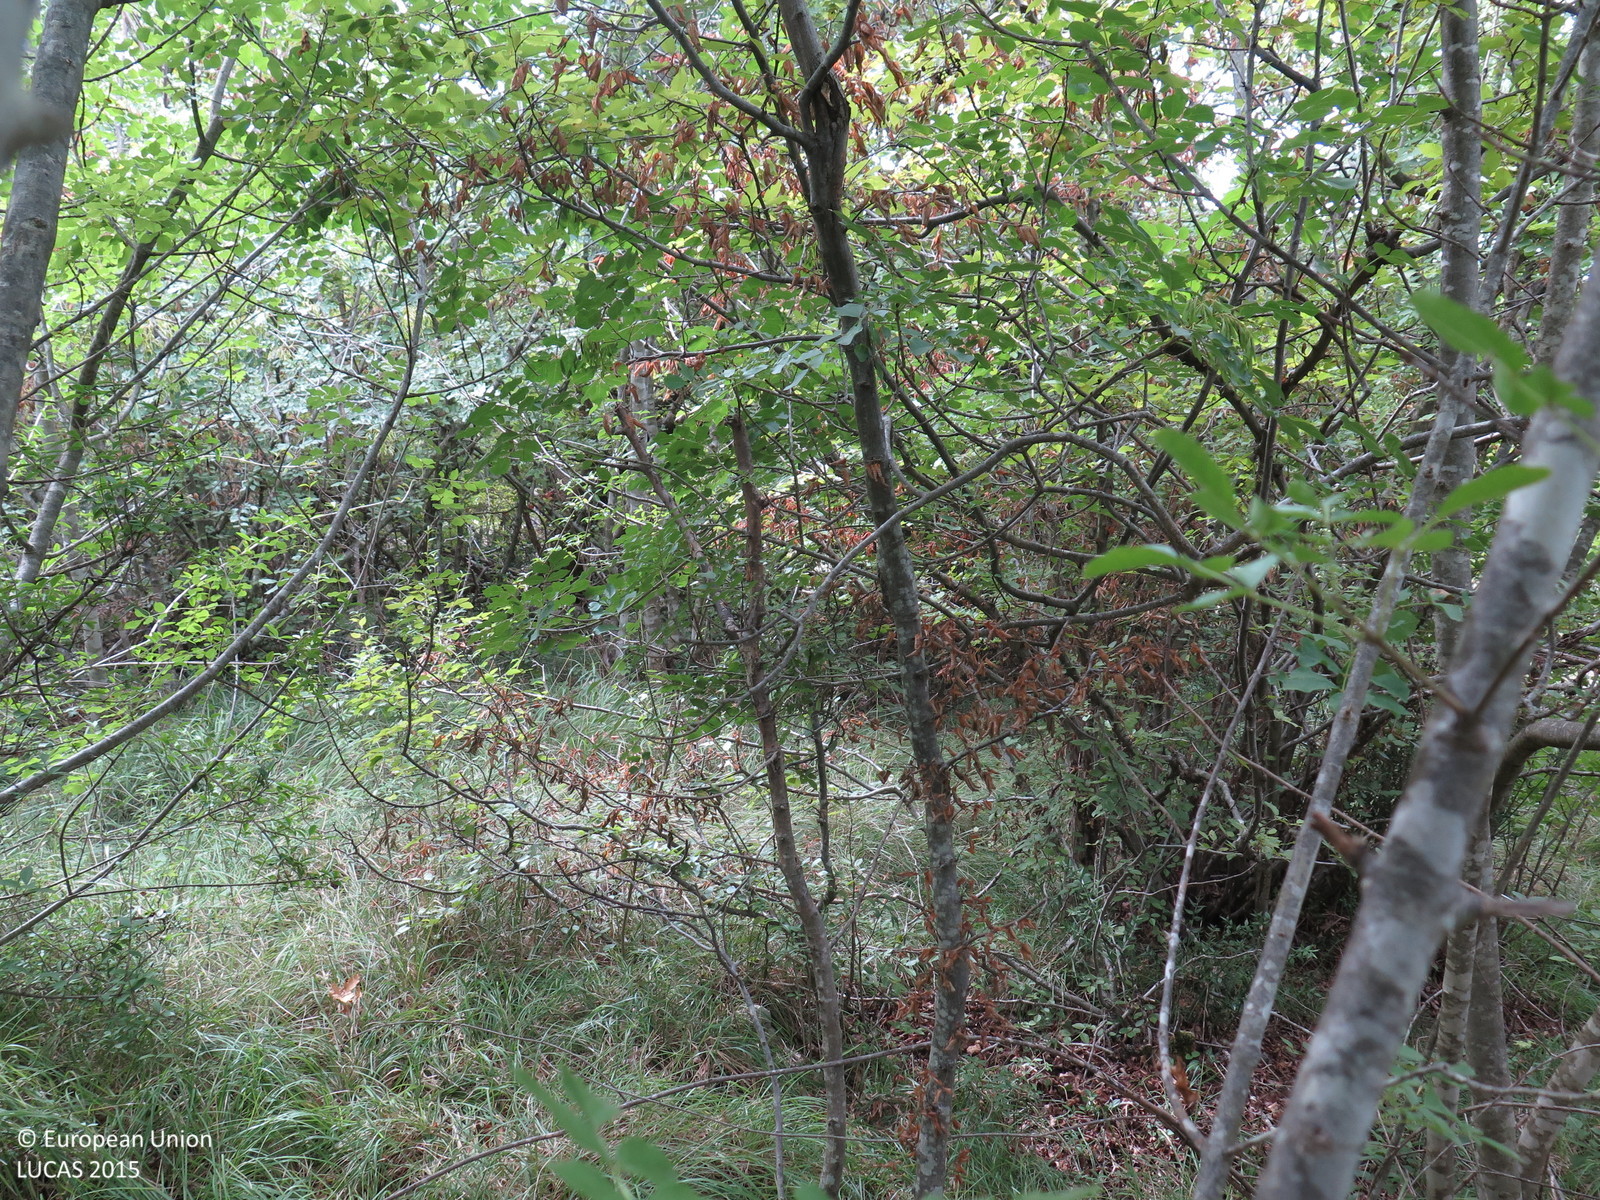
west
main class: Woodland
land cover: Broadleaved woodland
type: thermophilous deciduous forest
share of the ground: > 75 %
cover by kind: broadleaved forest trees 90 %, shrubs 5 %, herbaceous plants 5 %
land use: Semi-natural and natural areas not in use
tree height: > 5 m
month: August
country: HR
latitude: 45.1543
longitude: 14.5356
